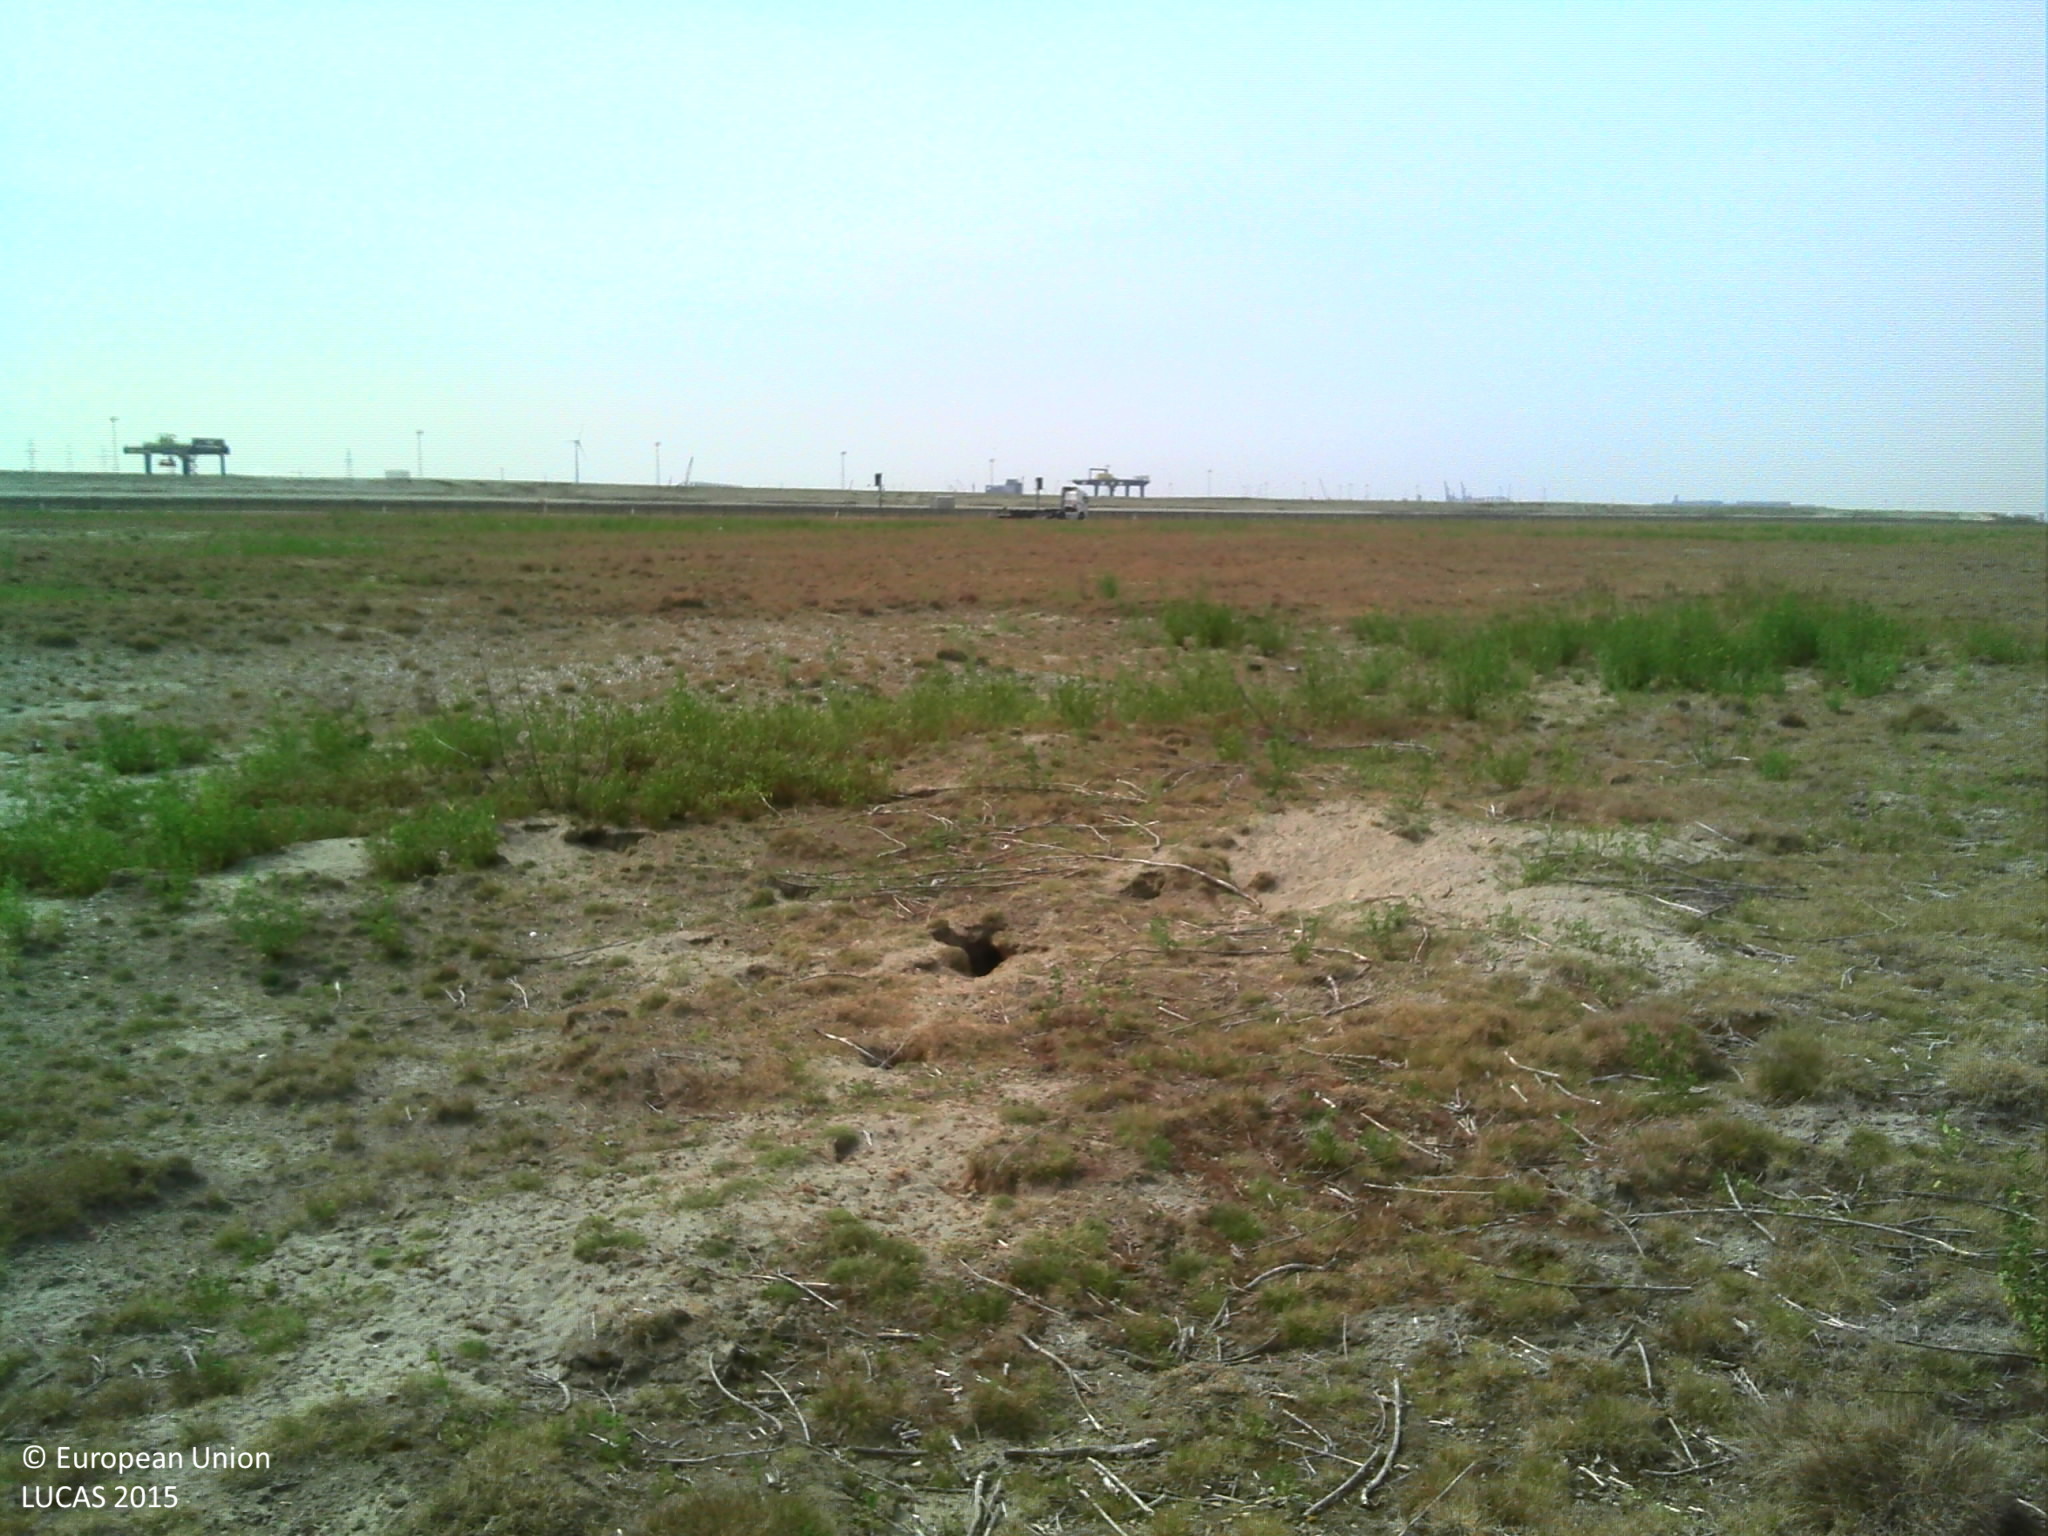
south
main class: Grassland
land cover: Spontaneously vegetated surfaces
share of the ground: > 75 %
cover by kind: herbaceous plants 100 %
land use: Semi-natural and natural areas not in use
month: June
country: BE
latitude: 51.3007
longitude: 4.2435
